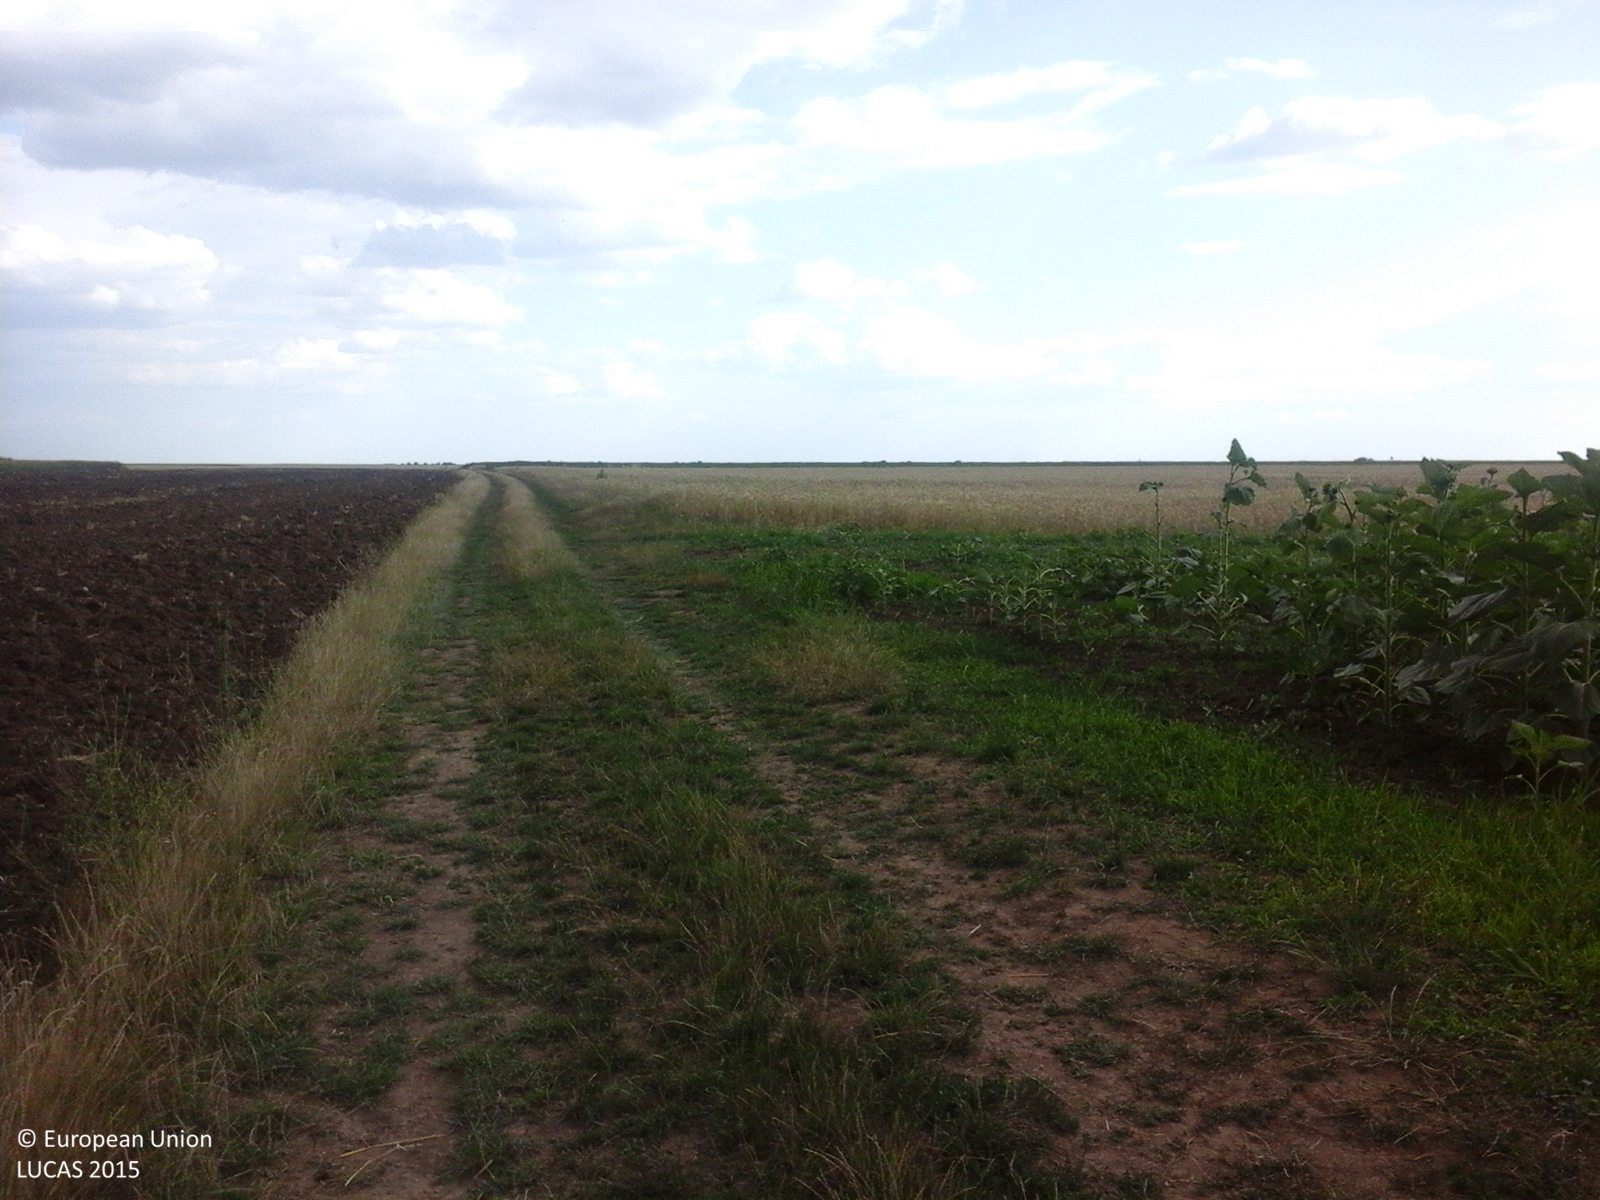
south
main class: Cropland
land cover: Sunflower
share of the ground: > 75 %
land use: Agriculture (excluding fallow land and kitchen gardens)
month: July
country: RO
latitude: 44.0848
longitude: 24.8227
